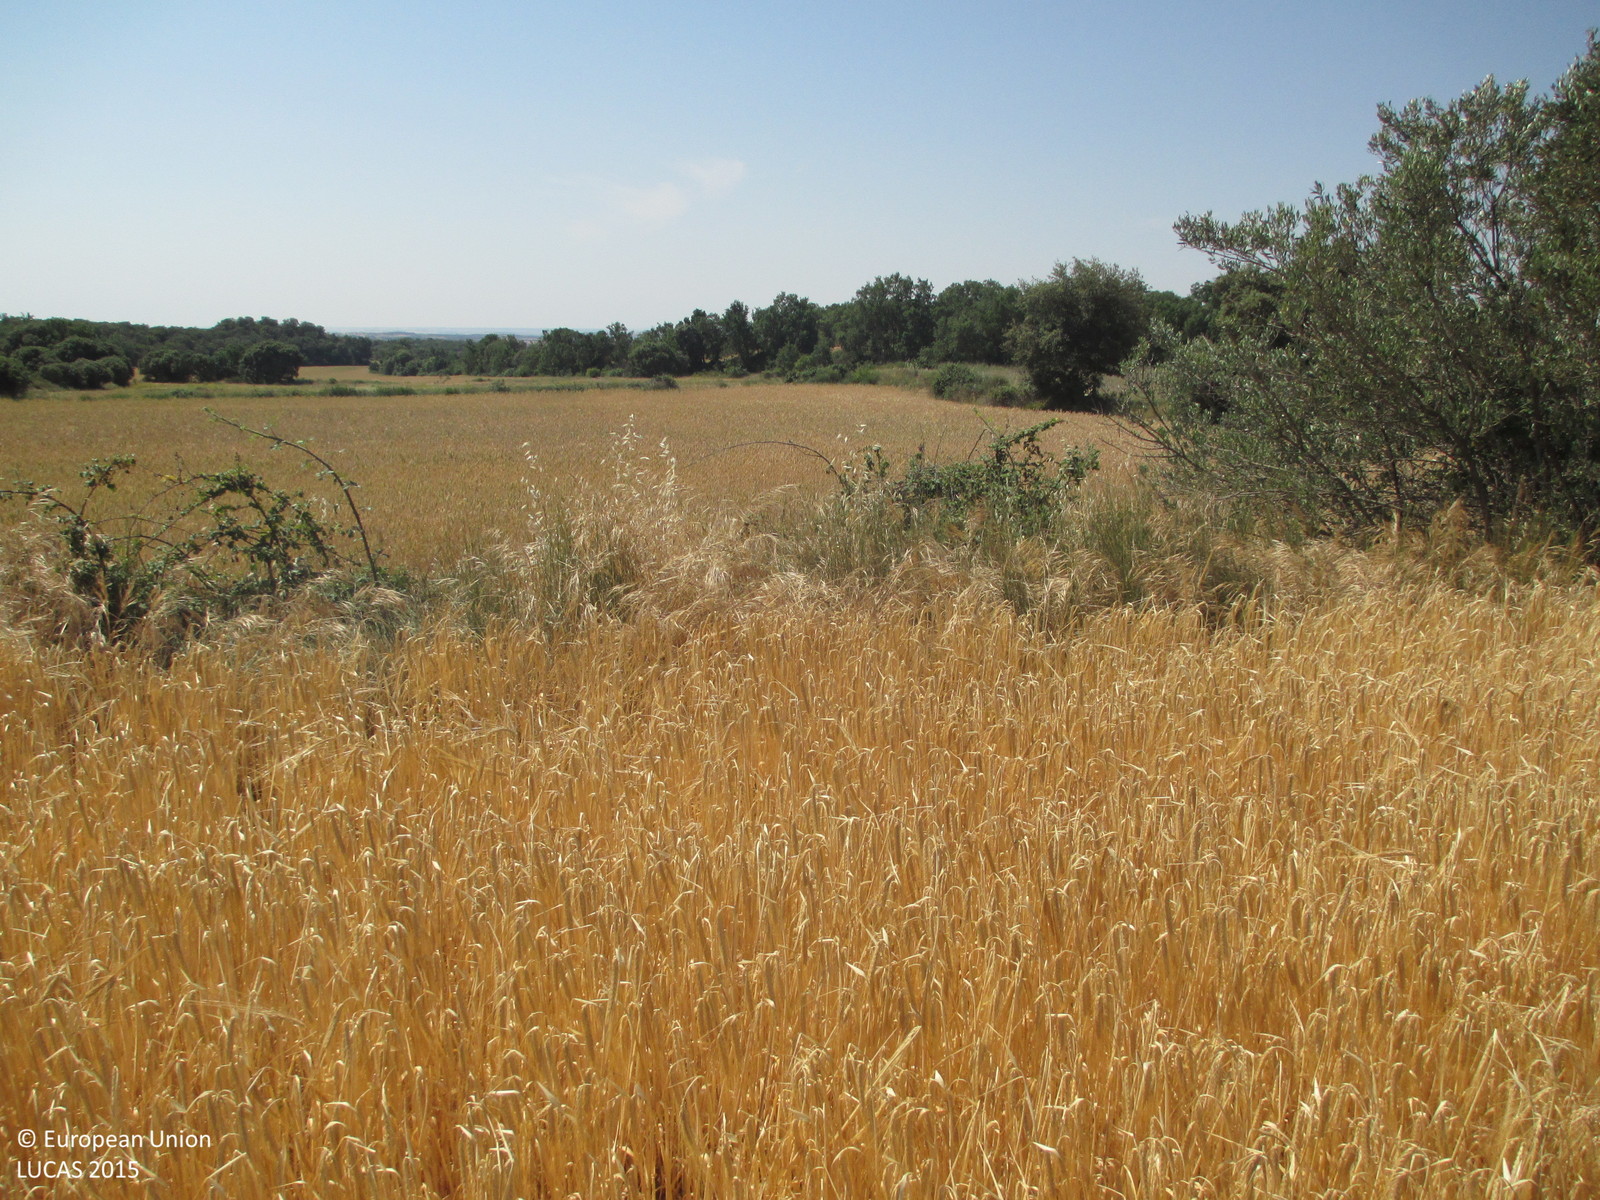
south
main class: Cropland
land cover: Barley
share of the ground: > 75 %
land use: Agriculture (excluding fallow land and kitchen gardens)
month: June
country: ES
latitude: 42.1561
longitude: -0.1994
